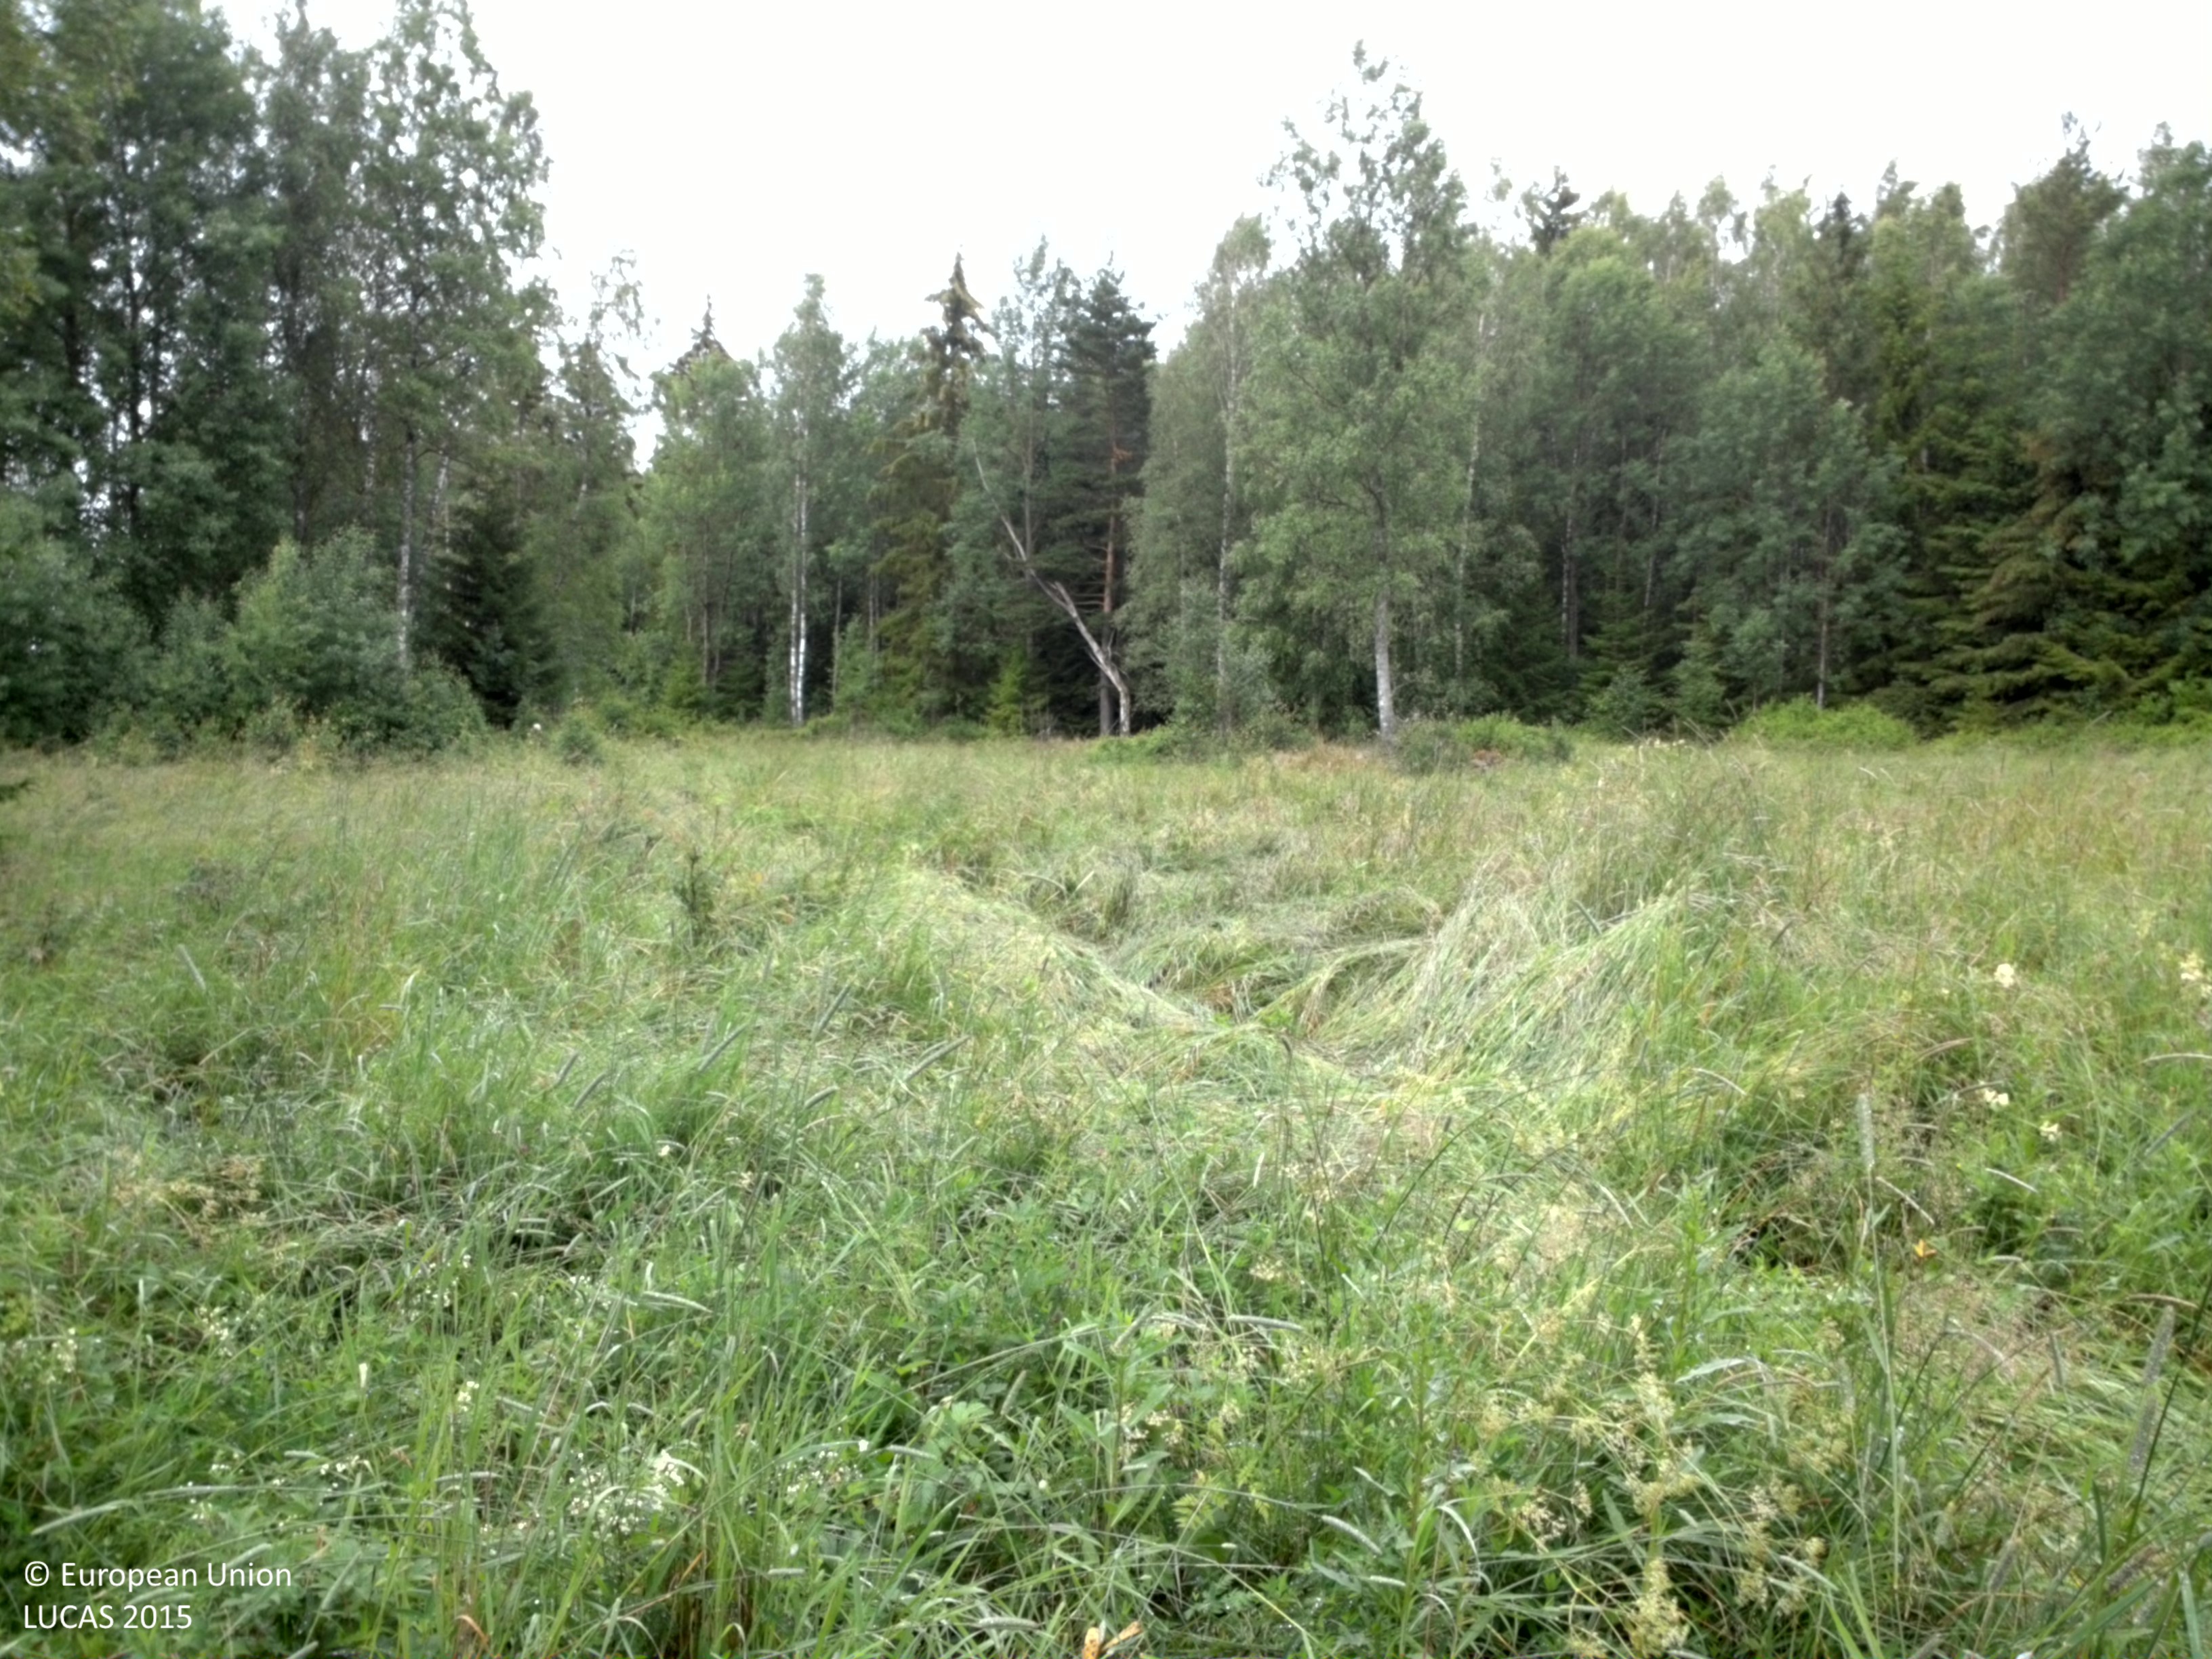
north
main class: Grassland
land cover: Grassland without tree/shrub cover
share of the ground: > 75 %
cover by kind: herbaceous plants 100 %
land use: Agriculture (excluding fallow land and kitchen gardens)
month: July
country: SE
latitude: 58.5194
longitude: 14.0282
